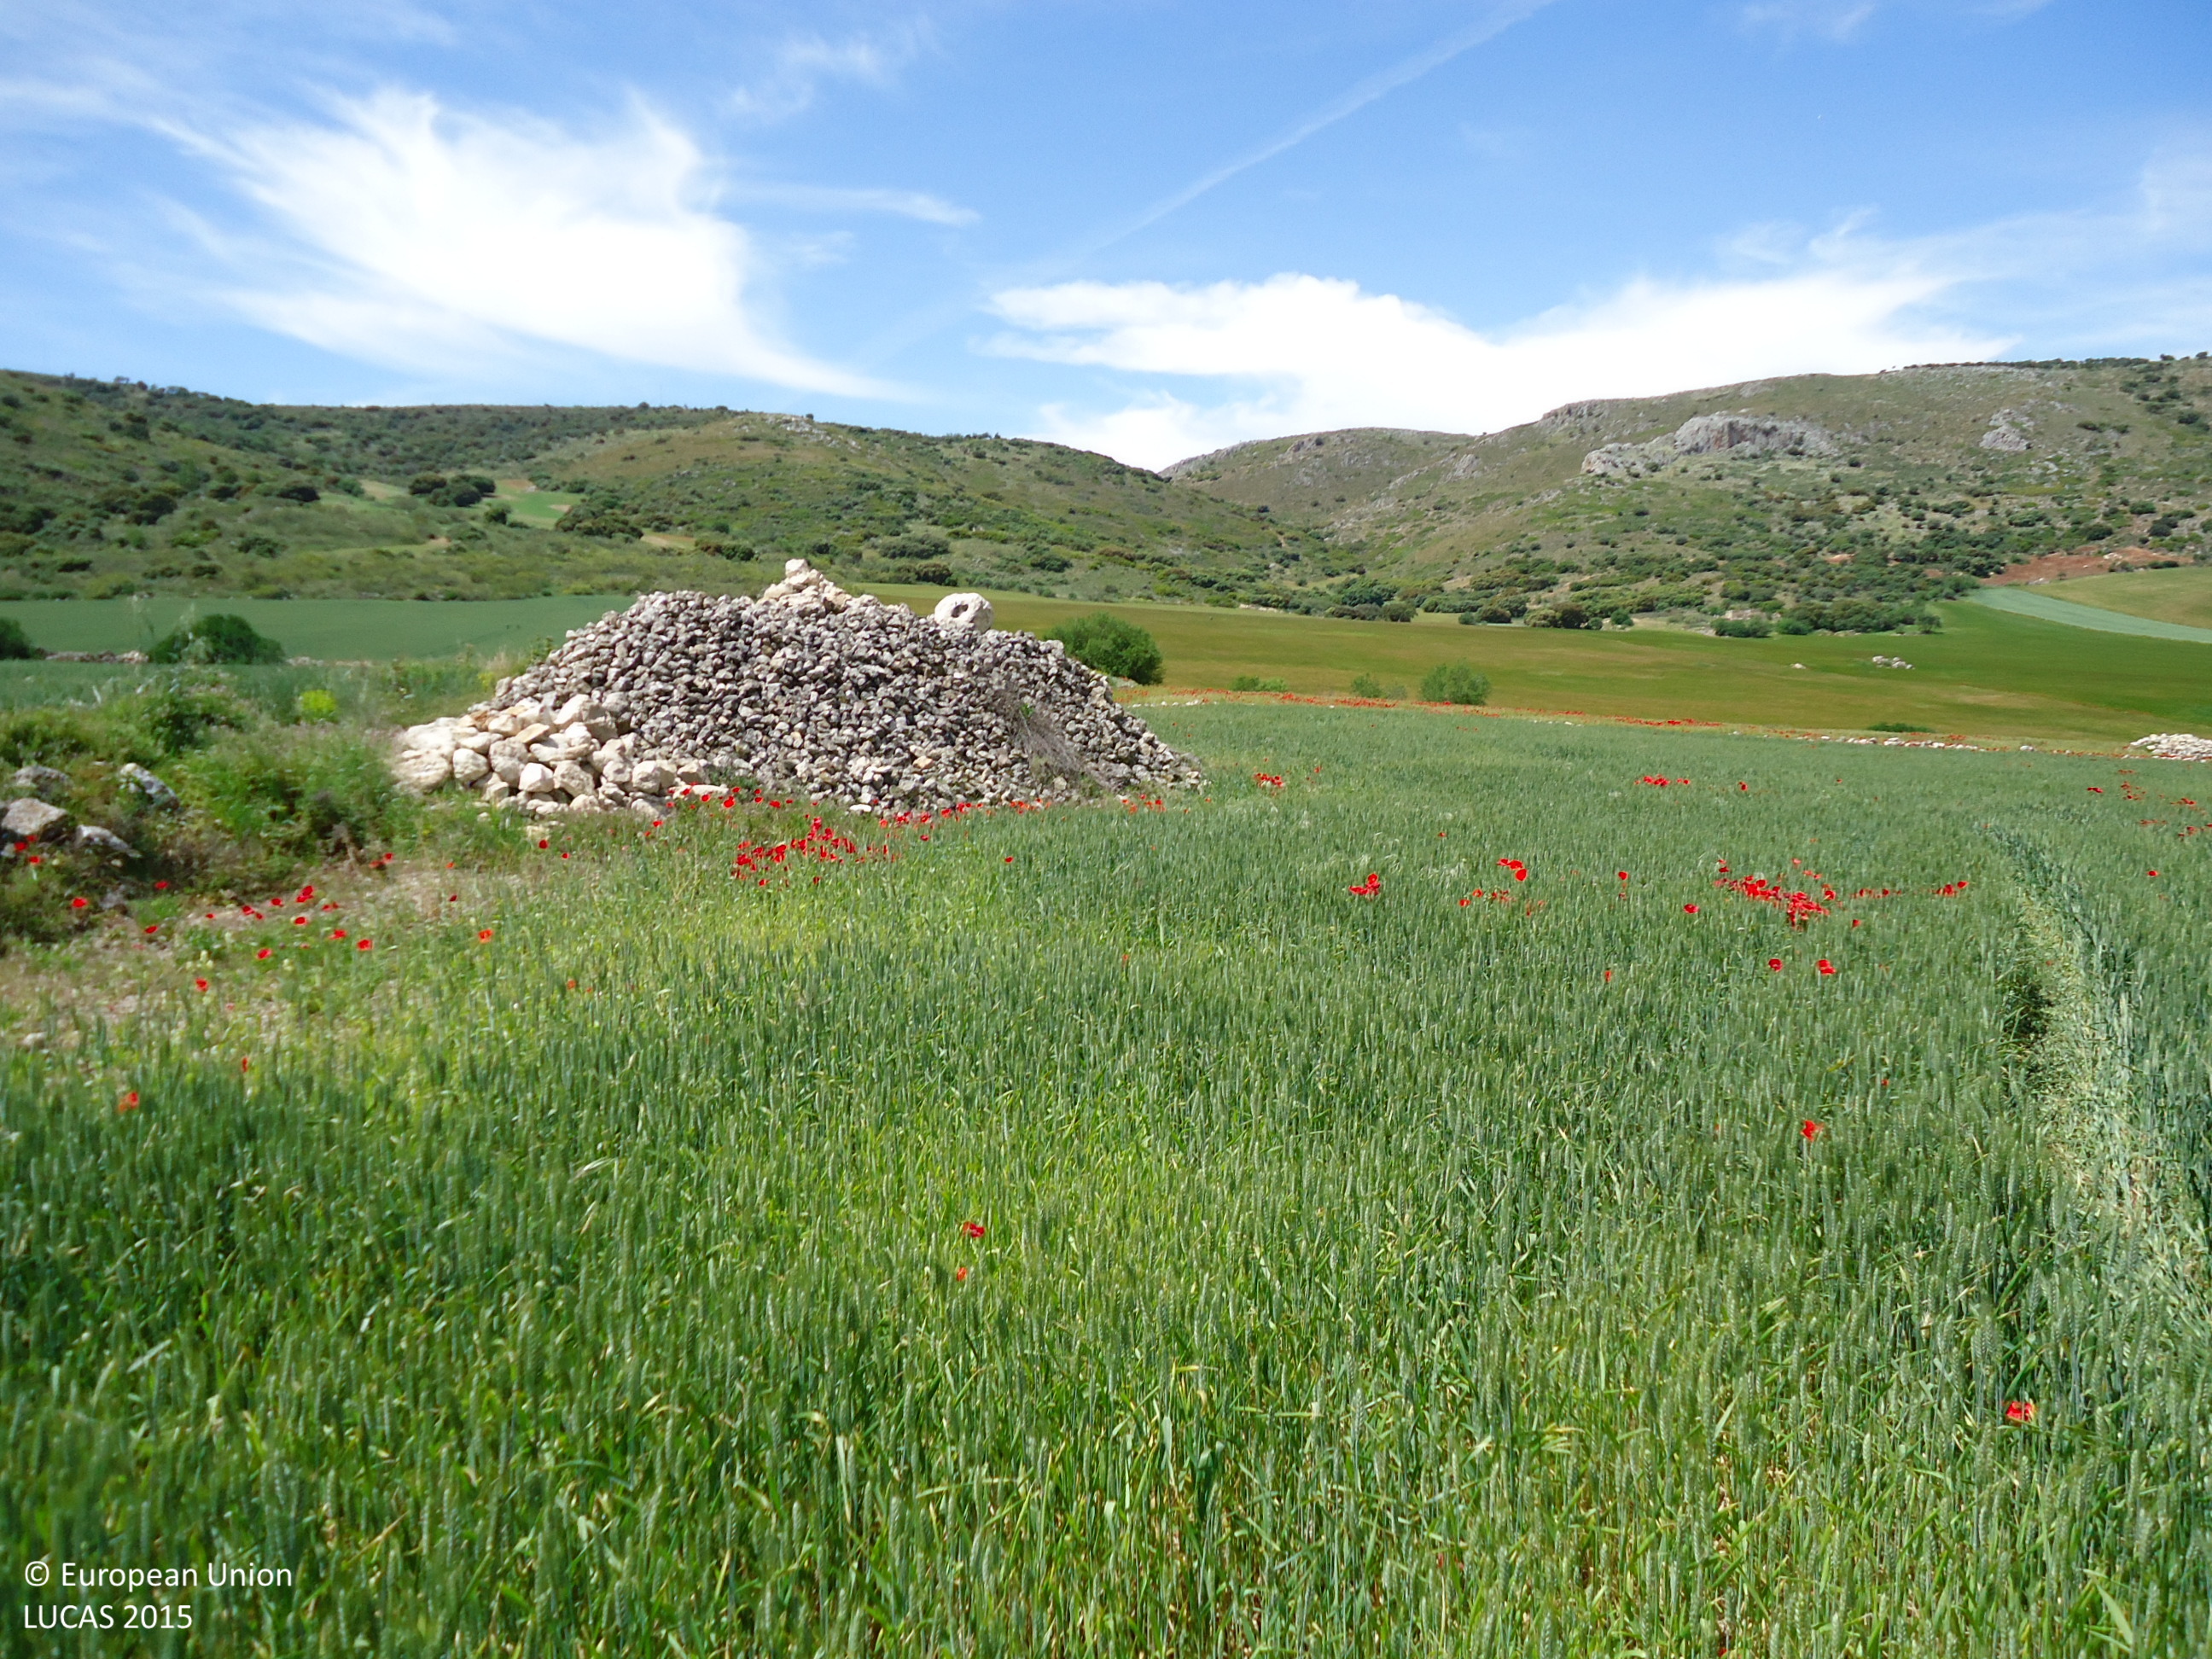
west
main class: Cropland
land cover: Common wheat
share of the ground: > 75 %
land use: Agriculture (excluding fallow land and kitchen gardens)
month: May
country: ES
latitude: 36.9742
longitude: -4.9977
